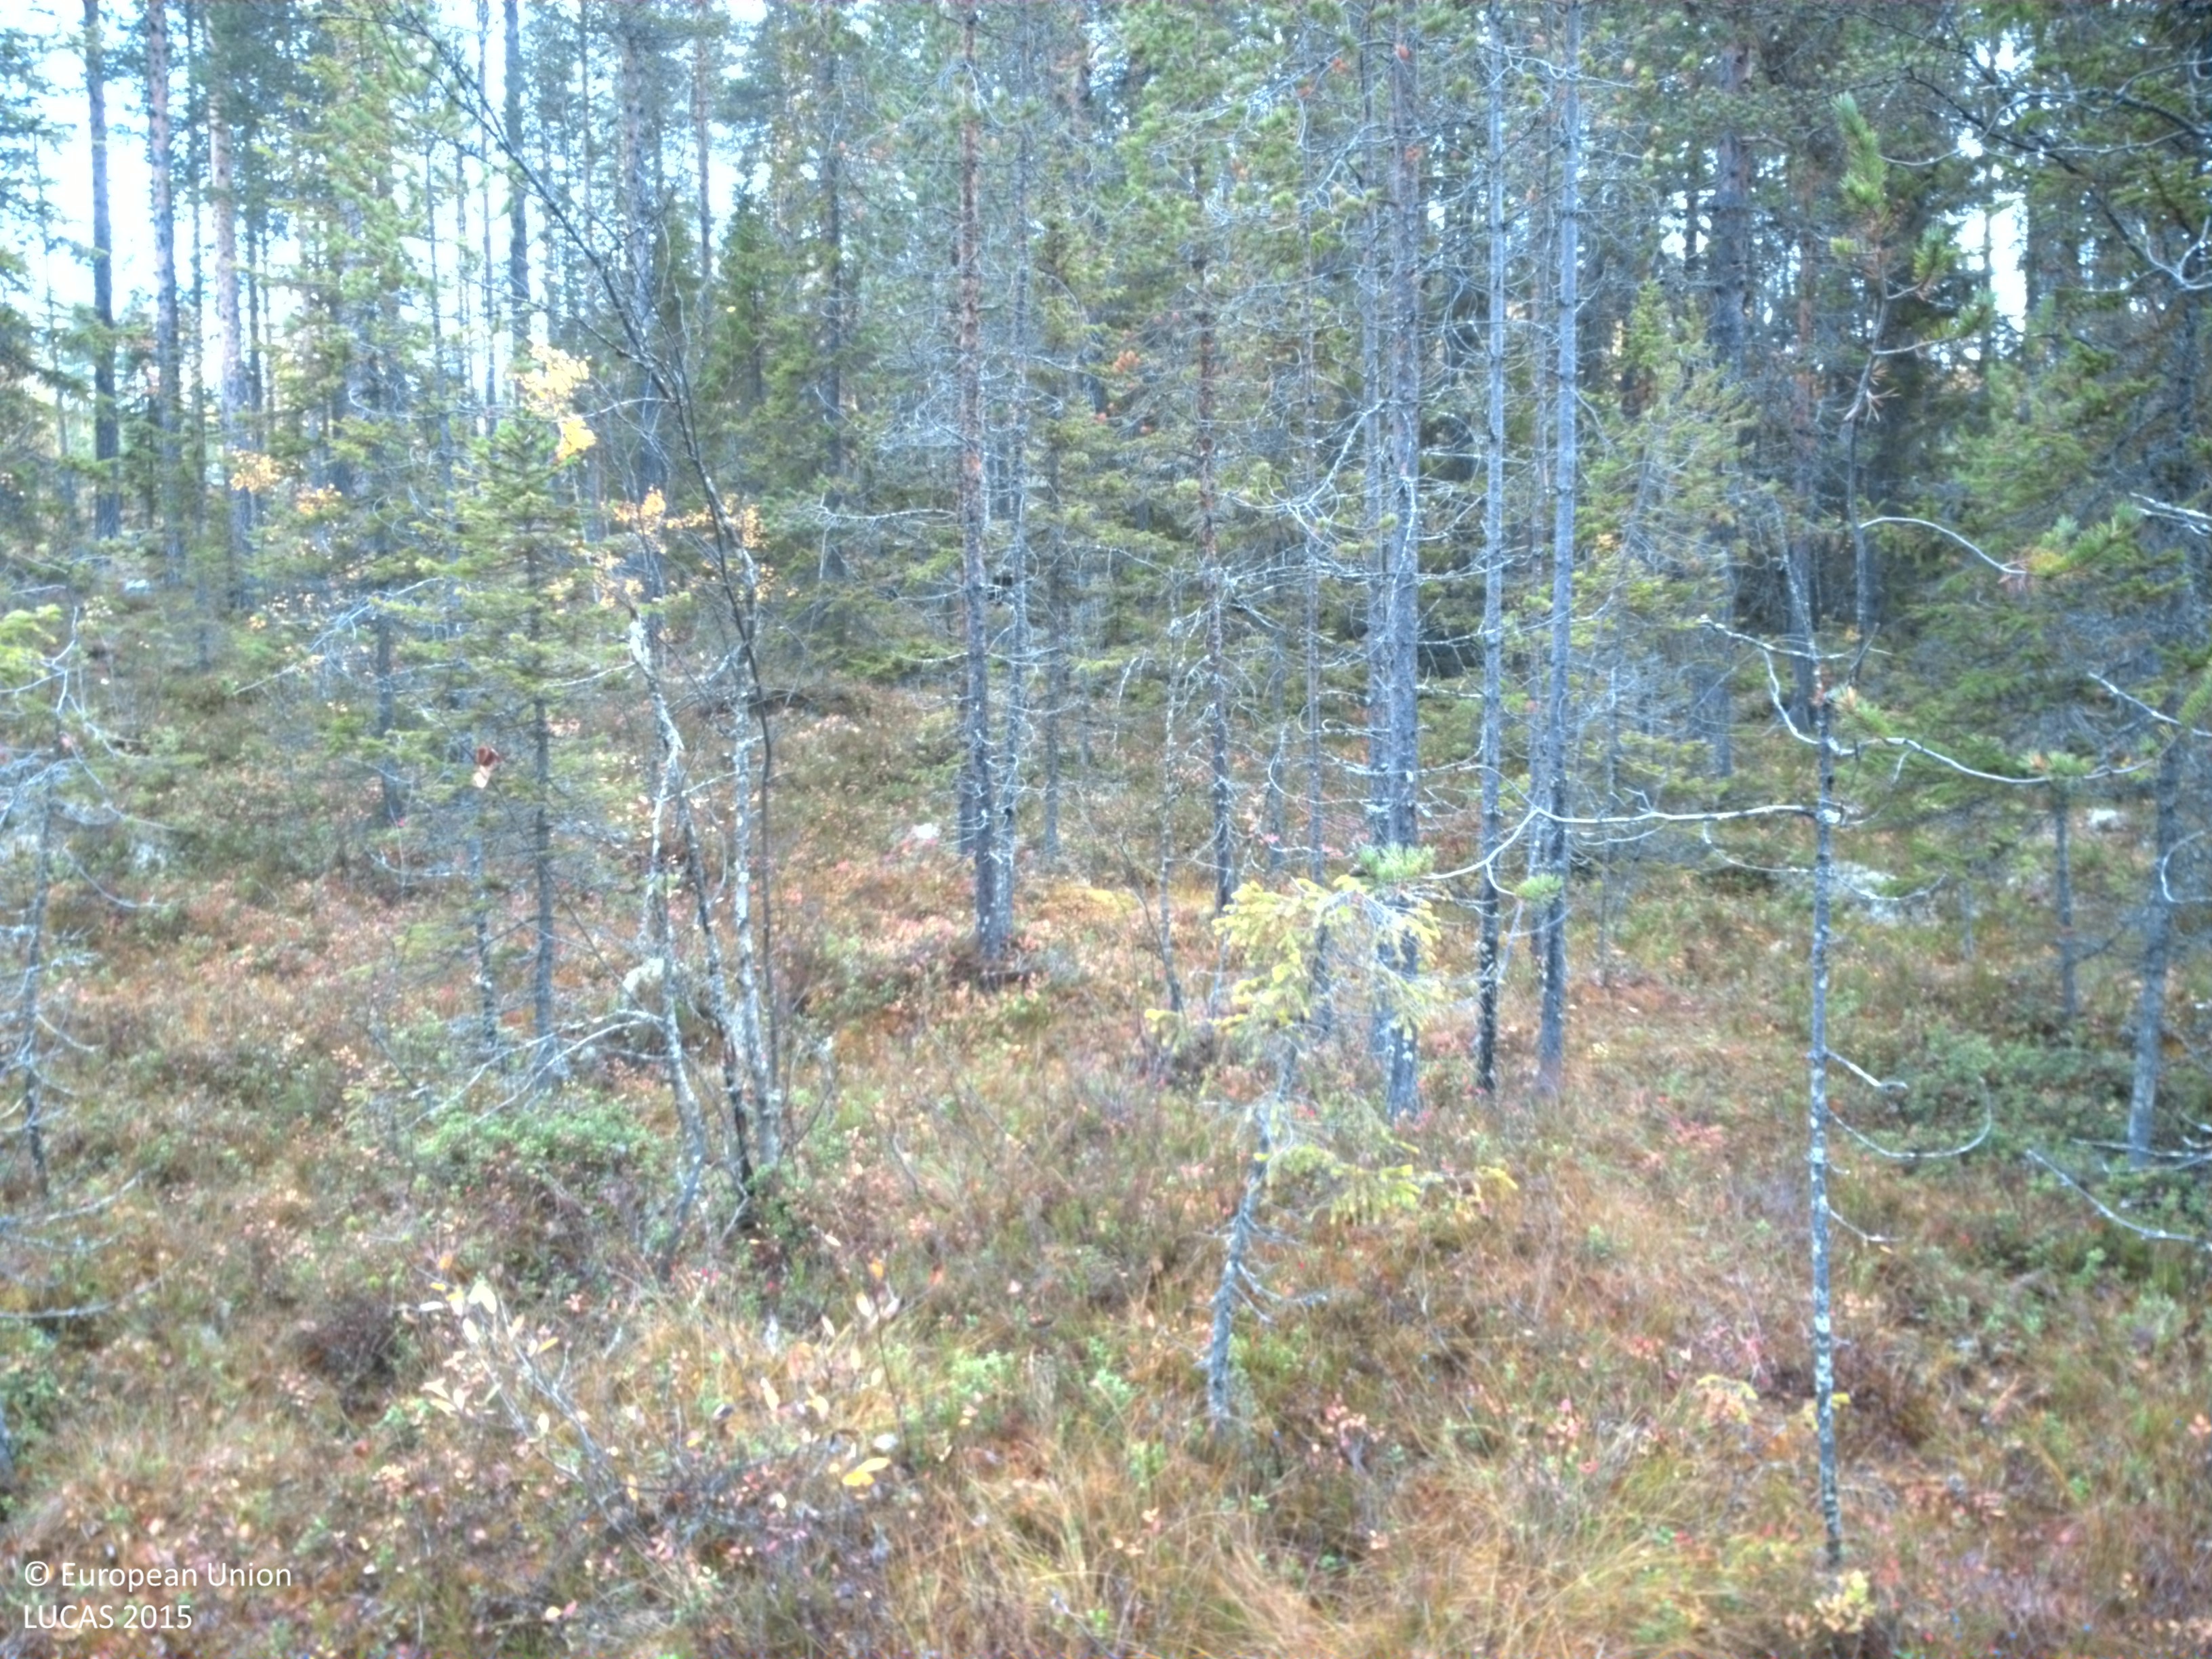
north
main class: Woodland
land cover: Pine dominated coniferous woodland
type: boreal forest
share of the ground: 25 - 50 %
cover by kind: coniferous forest trees 30 %, shrubs 25 %, lichens and mosses 25 %, herbaceous plants 15 %, broadleaved forest trees 5 %
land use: Forestry
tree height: > 5 m
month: October
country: SE
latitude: 64.9640
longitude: 17.5244
